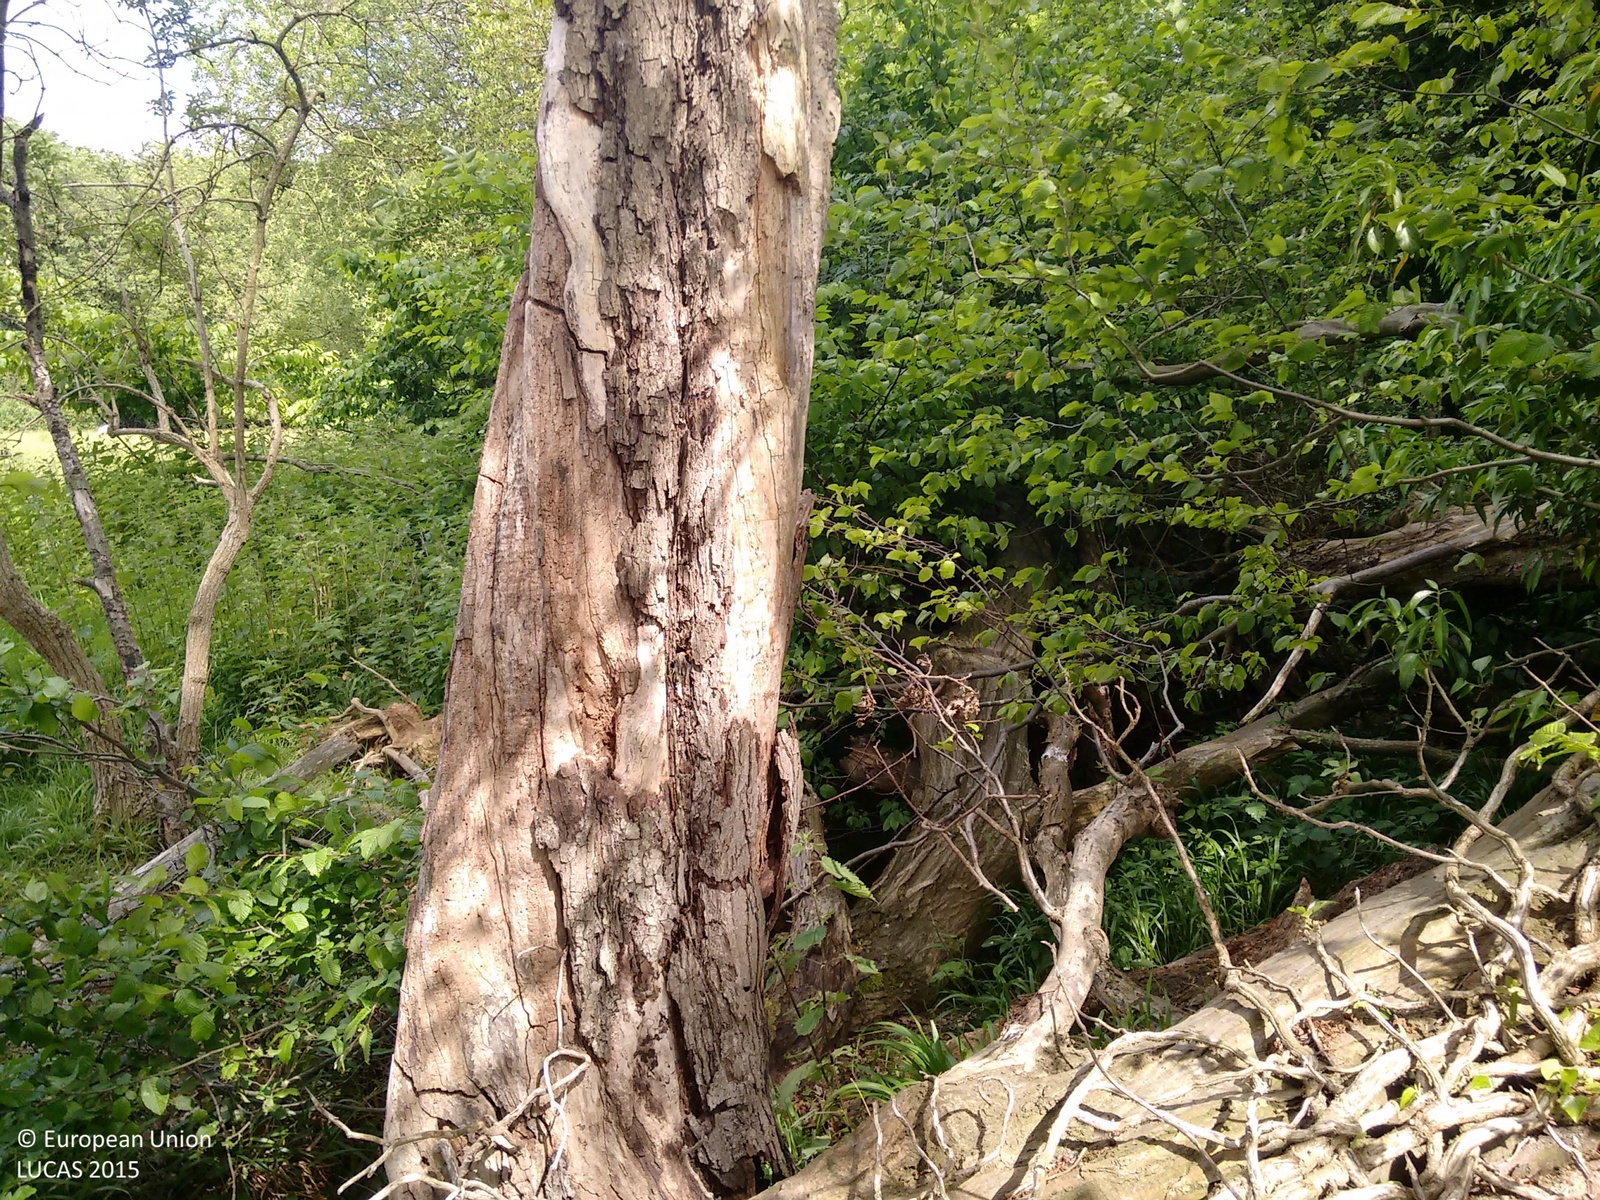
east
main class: Grassland
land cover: Grassland without tree/shrub cover
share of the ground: > 75 %
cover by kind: herbaceous plants 100 %
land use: Agriculture (excluding fallow land and kitchen gardens)
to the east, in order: Grassland without tree/shrub cover; Broadleaved woodland; Rivers and streams; Broadleaved woodland; Grassland without tree/shrub cover; Fences; Broadleaved woodland
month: June
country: GB
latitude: 51.0824
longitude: 0.6231
